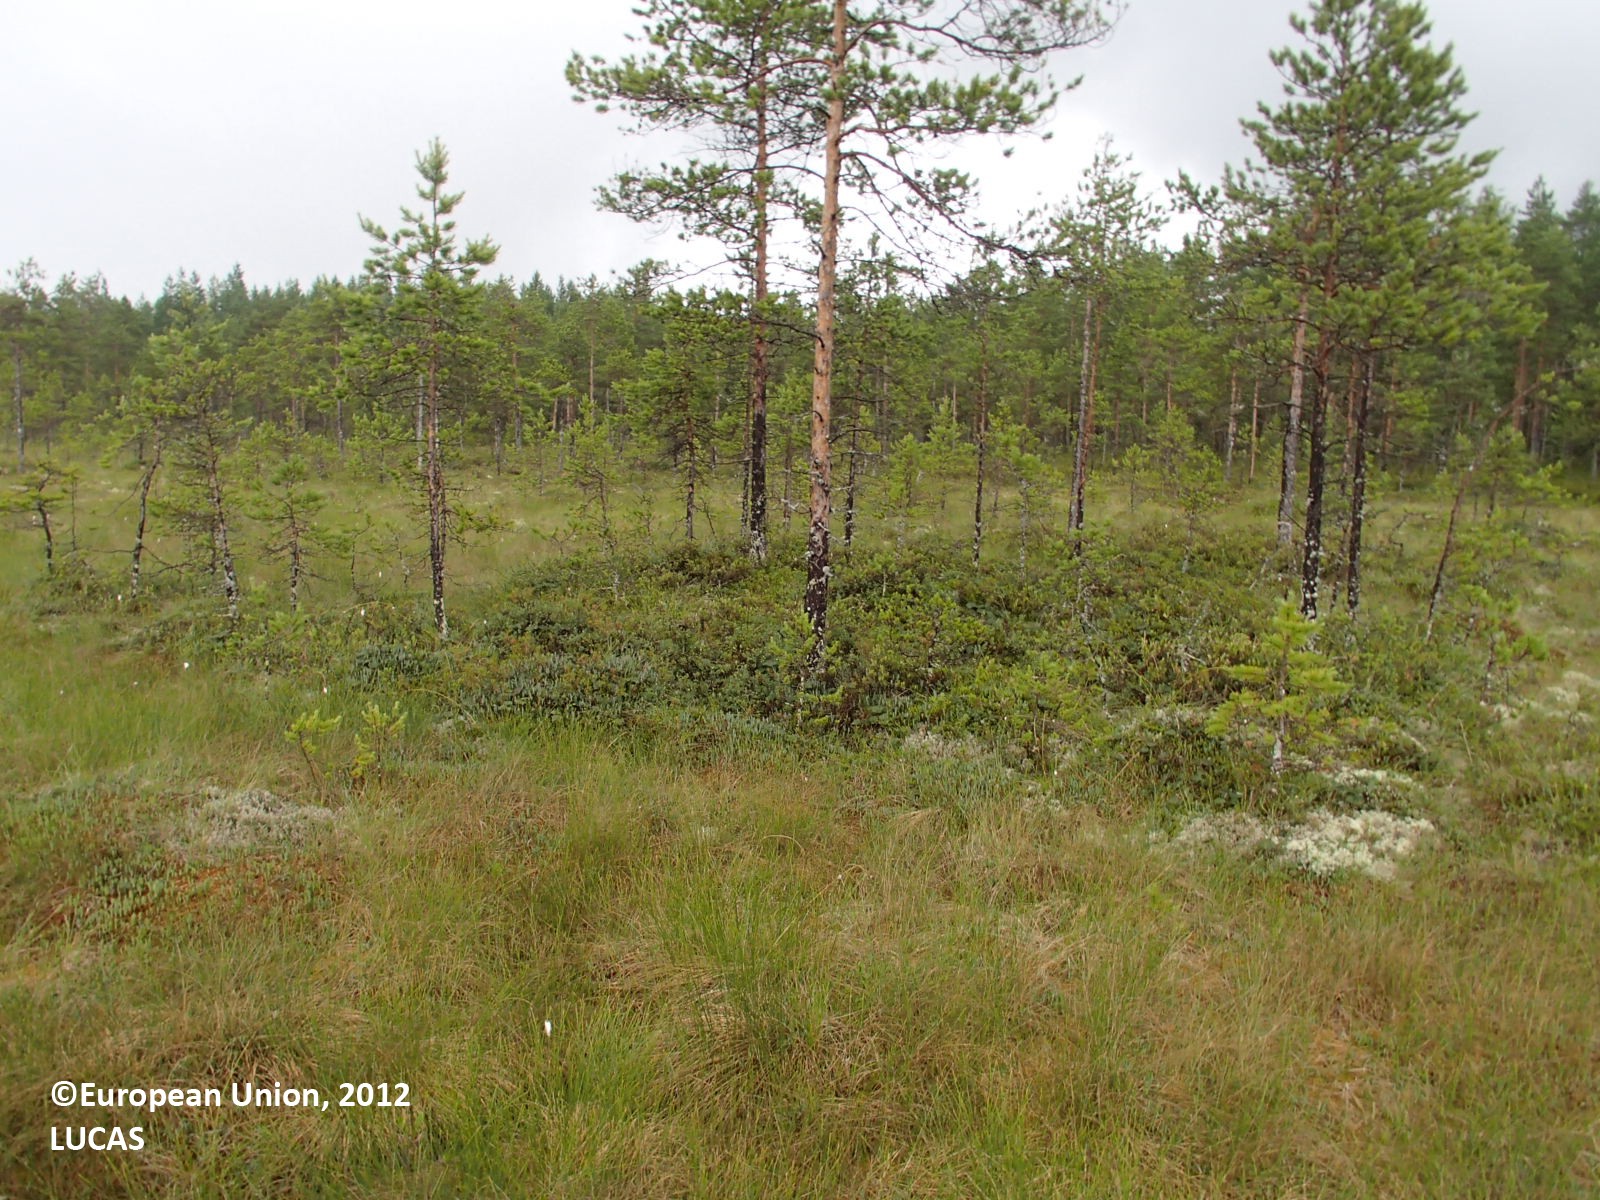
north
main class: Woodland
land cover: Pine dominated coniferous woodland
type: mire and swamp forests
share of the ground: 25 - 50 %
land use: Semi-natural and natural areas not in use
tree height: > 5 m
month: July
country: FI
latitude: 64.2500
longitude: 26.3074
